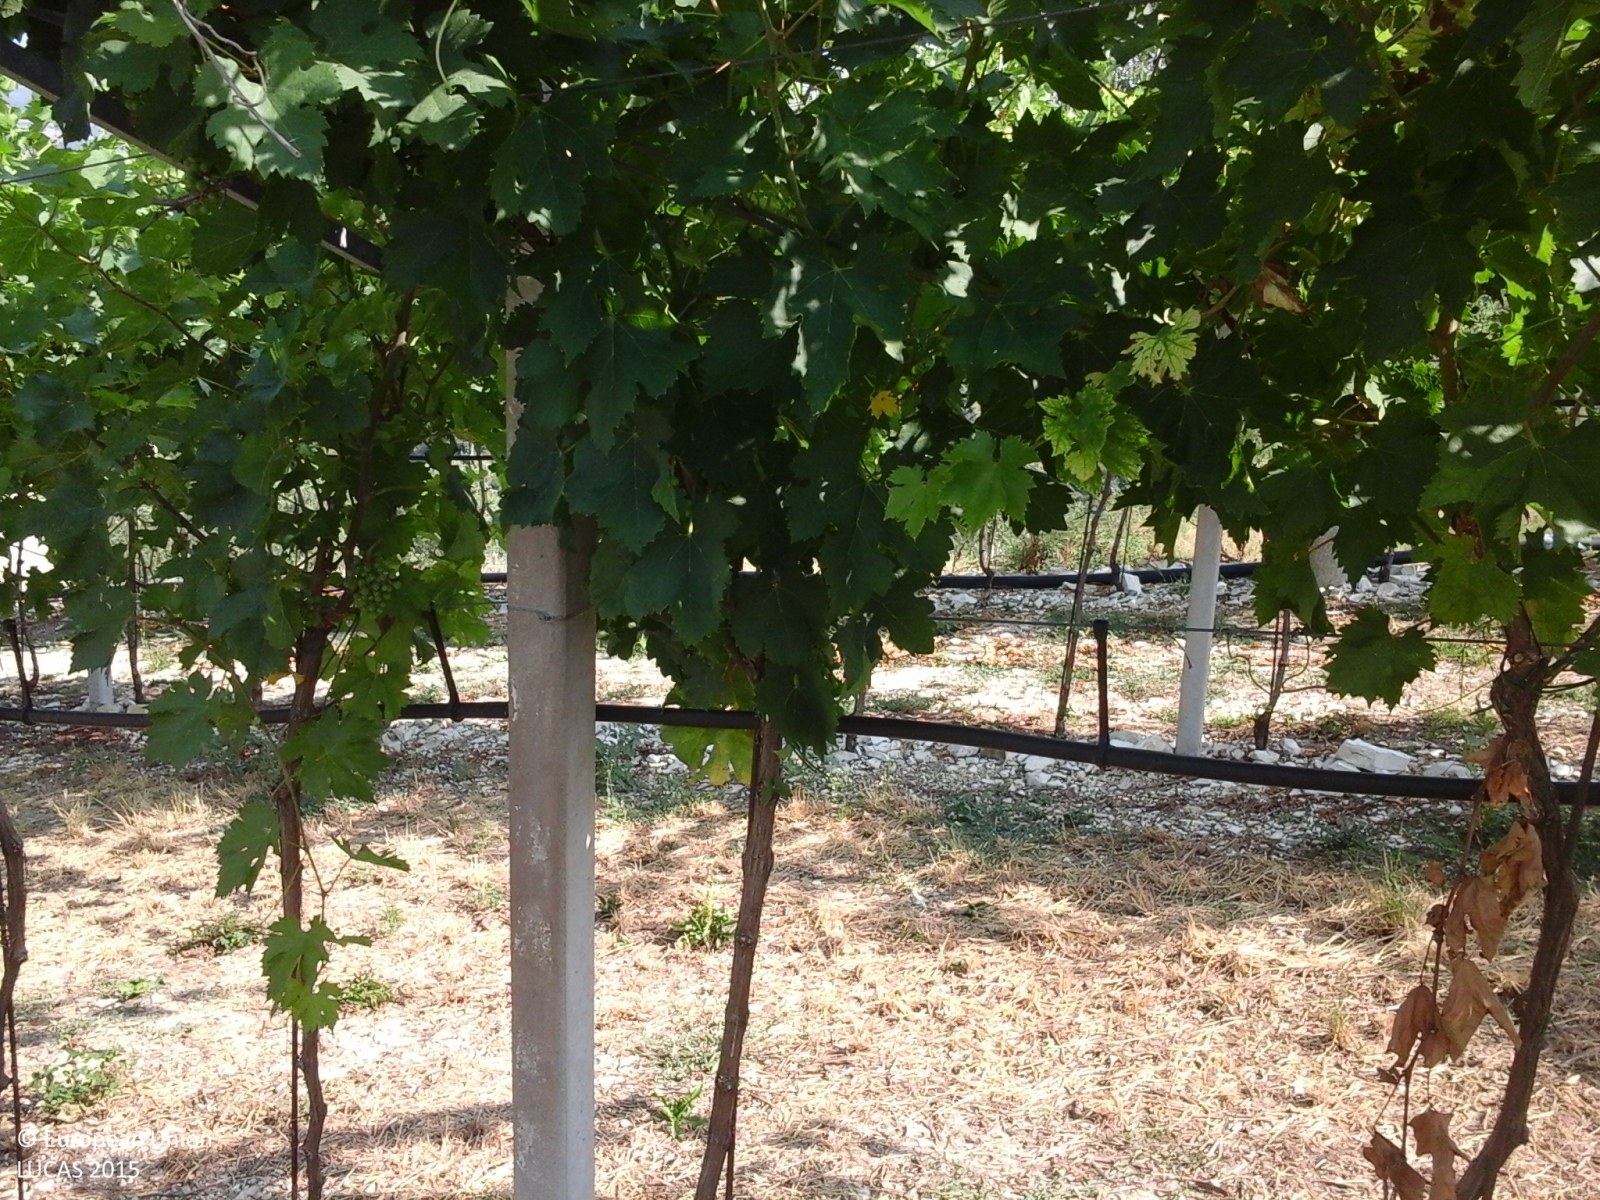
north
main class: Cropland
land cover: Vineyards
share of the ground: 25 - 50 %
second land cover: Grassland without tree/shrub cover
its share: > 75 %
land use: Agriculture (excluding fallow land and kitchen gardens)
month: July
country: IT
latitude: 45.4983
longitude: 11.1370
